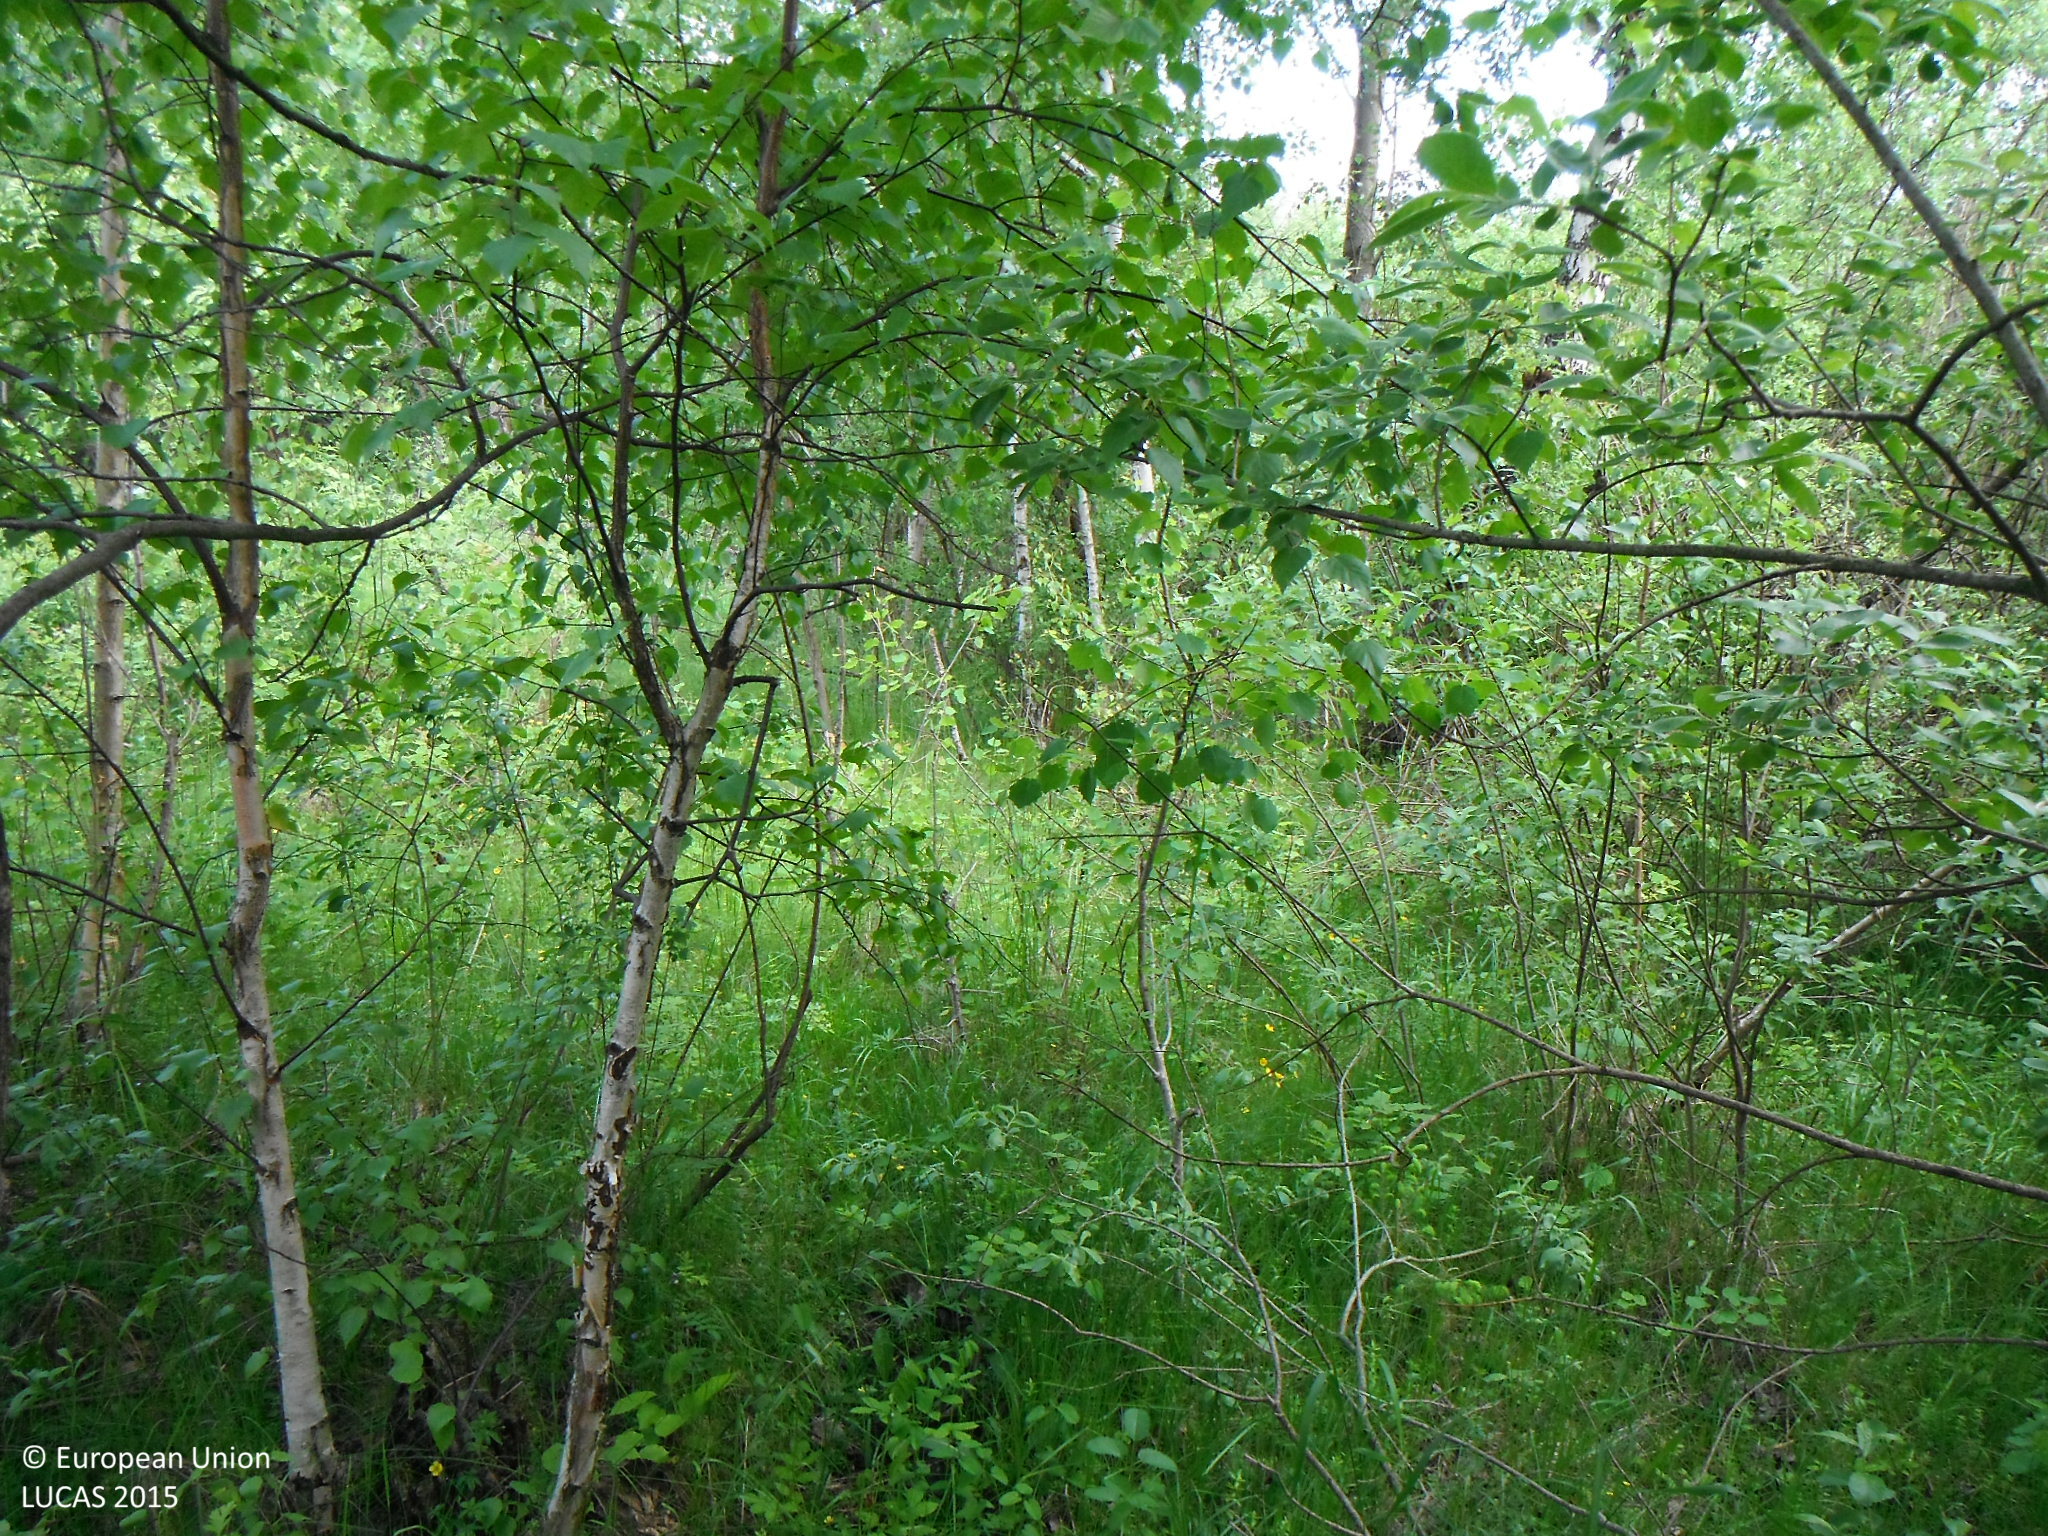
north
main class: Woodland
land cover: Broadleaved woodland
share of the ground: > 75 %
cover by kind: broadleaved forest trees 85 %, herbaceous plants 10 %, shrubs 5 %
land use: Forestry
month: June
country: SK
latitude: 48.4912
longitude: 19.4012
